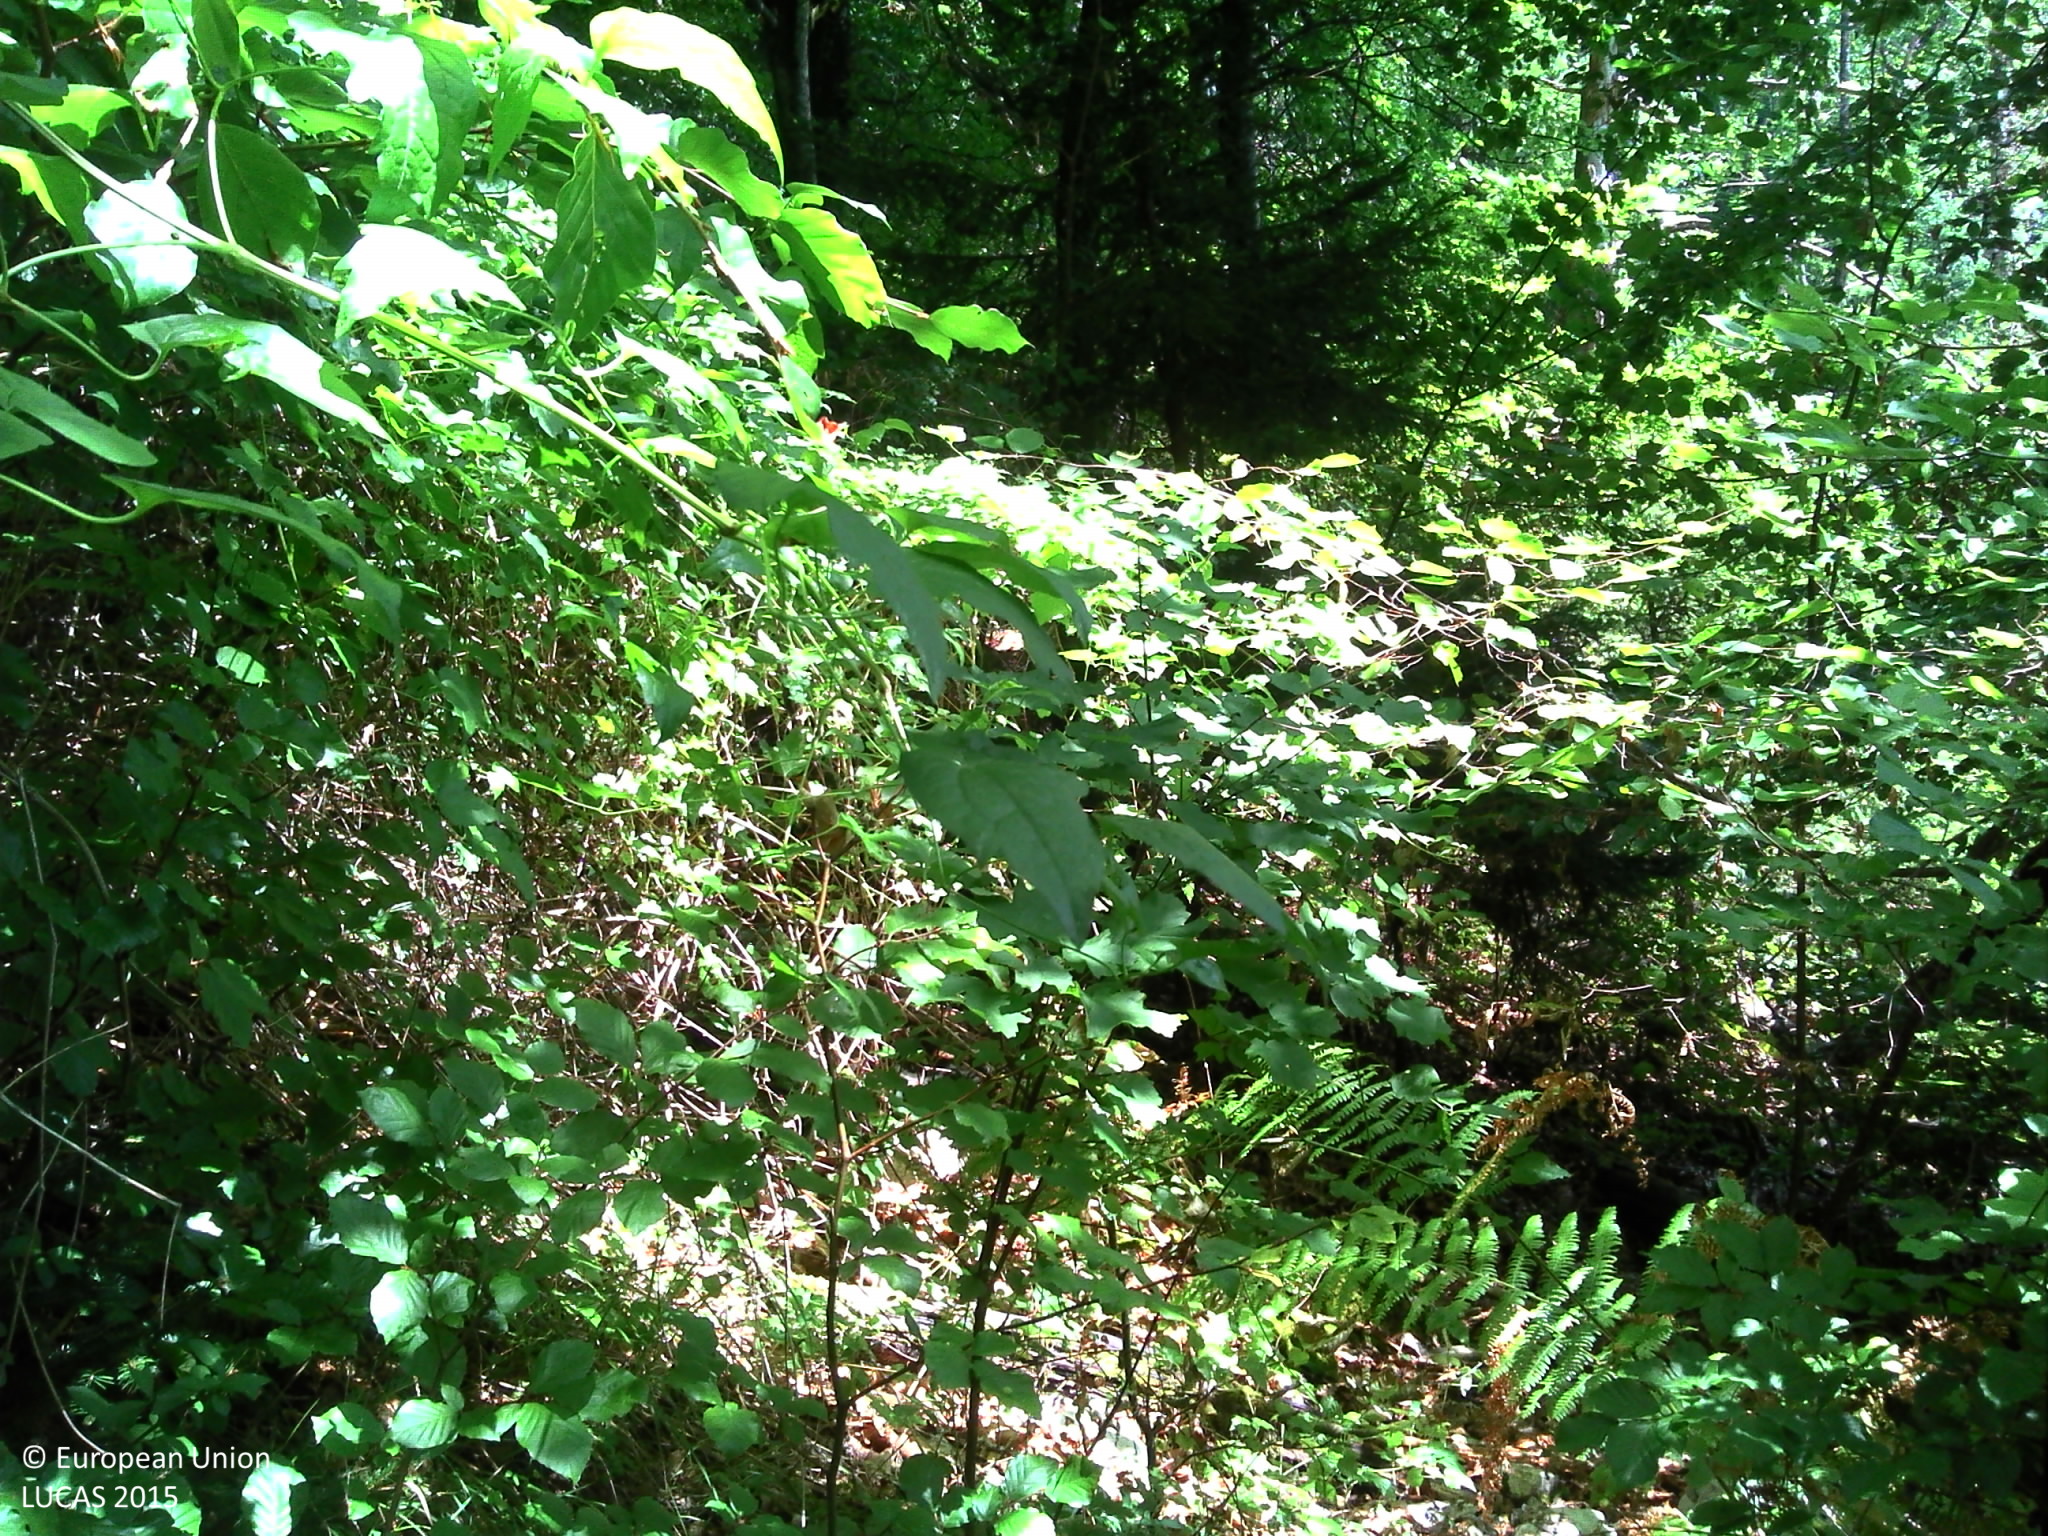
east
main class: Woodland
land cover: Pine dominated mixed woodland
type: beech forest
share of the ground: > 75 %
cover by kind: coniferous forest trees 40 %, broadleaved forest trees 35 %, herbaceous plants 20 %, lichens and mosses 5 %
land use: Forestry
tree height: > 5 m
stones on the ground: > 50 %
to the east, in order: Pine dominated mixed woodland; Rocks and stones; Pine dominated mixed woodland; Tracks; Pine dominated mixed woodland; Fences; Grassland without tree/shrub cover
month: July
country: FR
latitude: 46.0930
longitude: 6.4209
